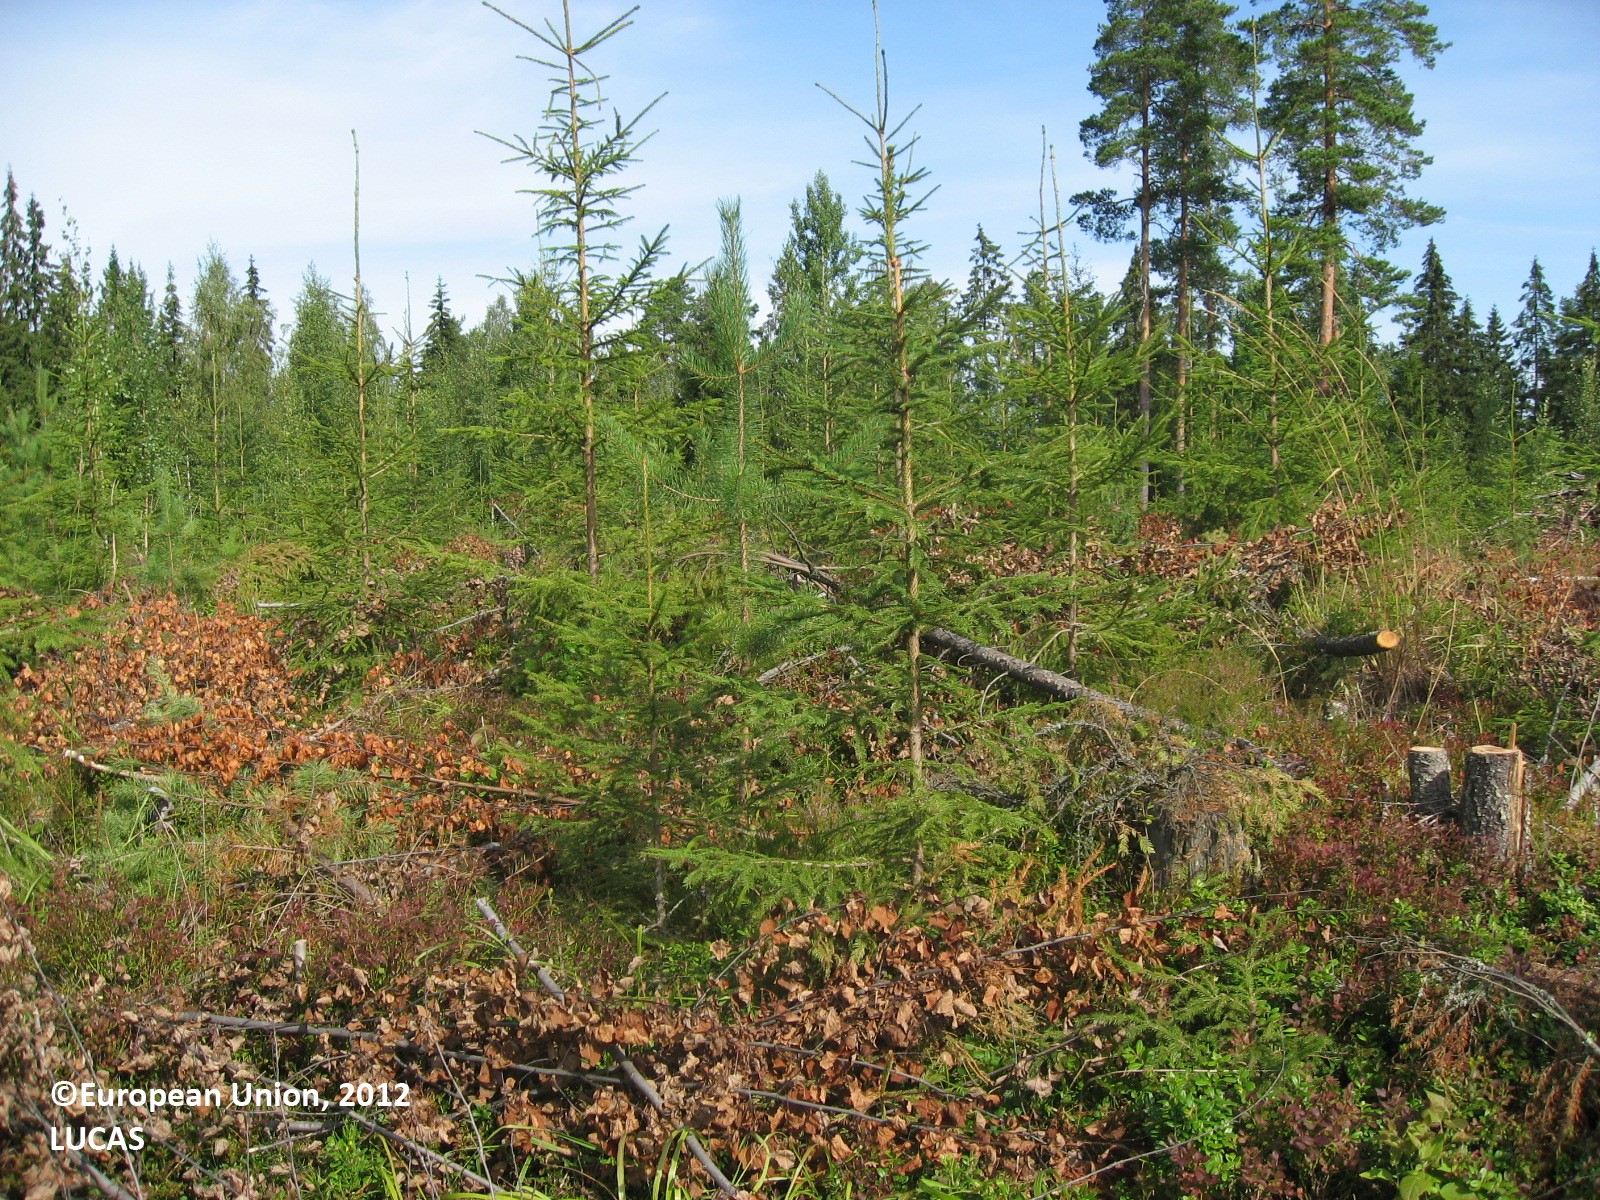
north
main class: Woodland
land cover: Spruce dominated coniferous woodland
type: boreal forest
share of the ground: 25 - 50 %
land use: Forestry
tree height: < 5 m
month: August
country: FI
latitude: 61.5816
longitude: 24.9697
